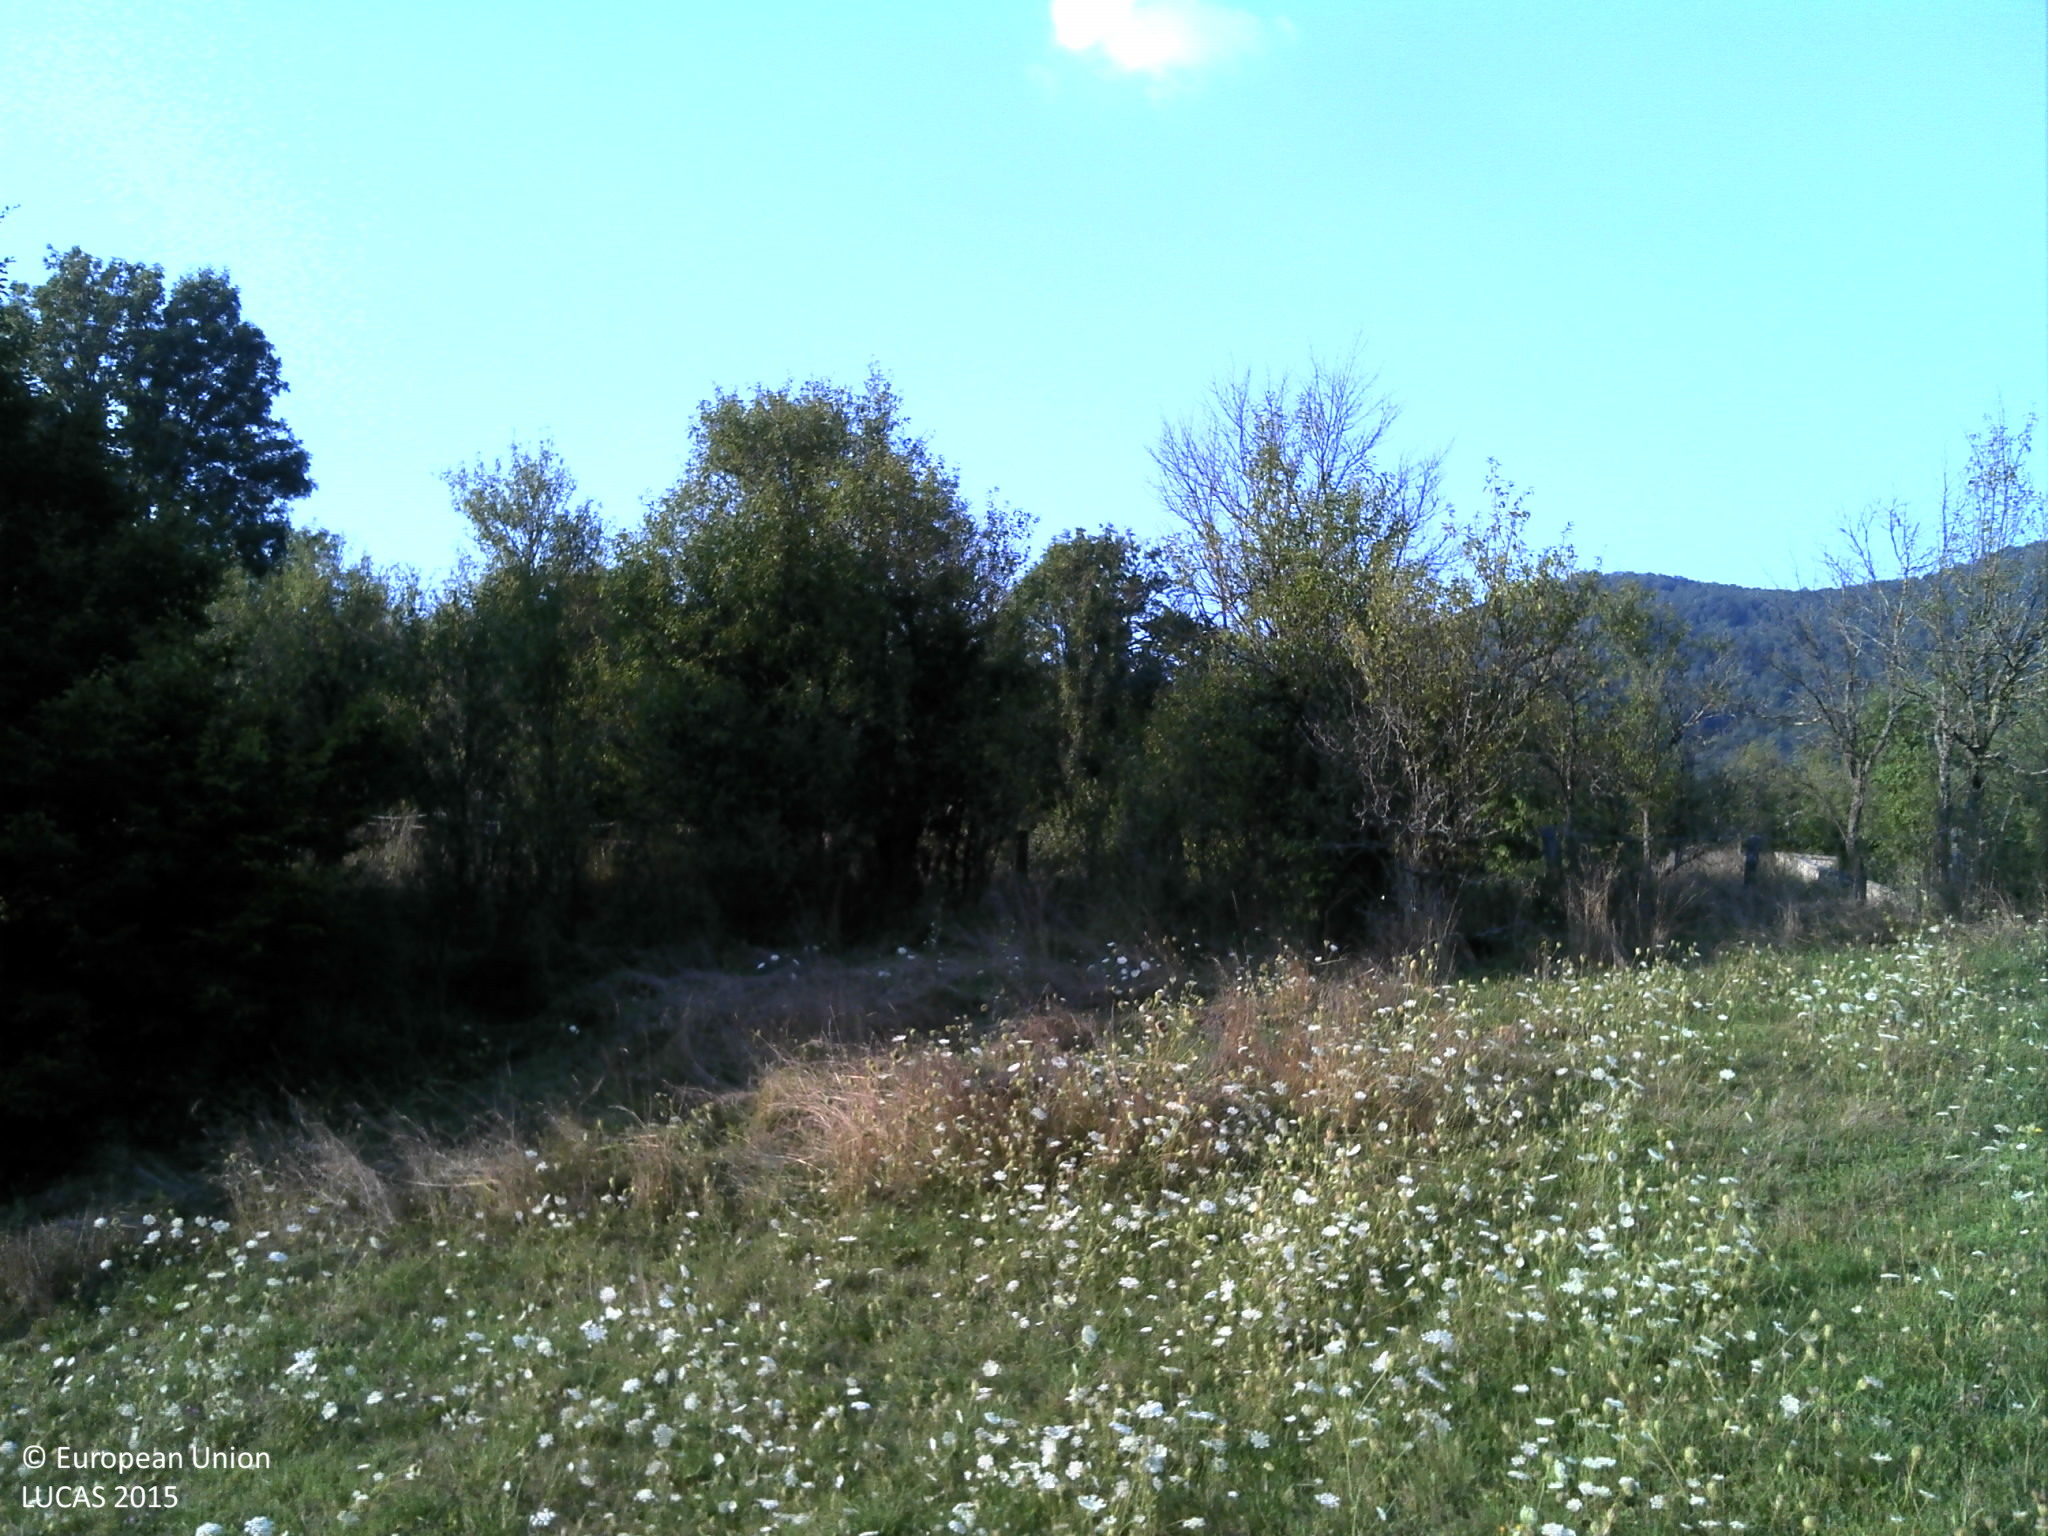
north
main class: Grassland
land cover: Grassland with sparse tree/shrub cover
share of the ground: > 75 %
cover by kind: herbaceous plants 90 %, broadleaved forest trees 5 %, shrubs 5 %
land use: Agriculture (excluding fallow land and kitchen gardens)
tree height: < 5 m
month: August
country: HR
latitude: 45.0053
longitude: 15.0312
